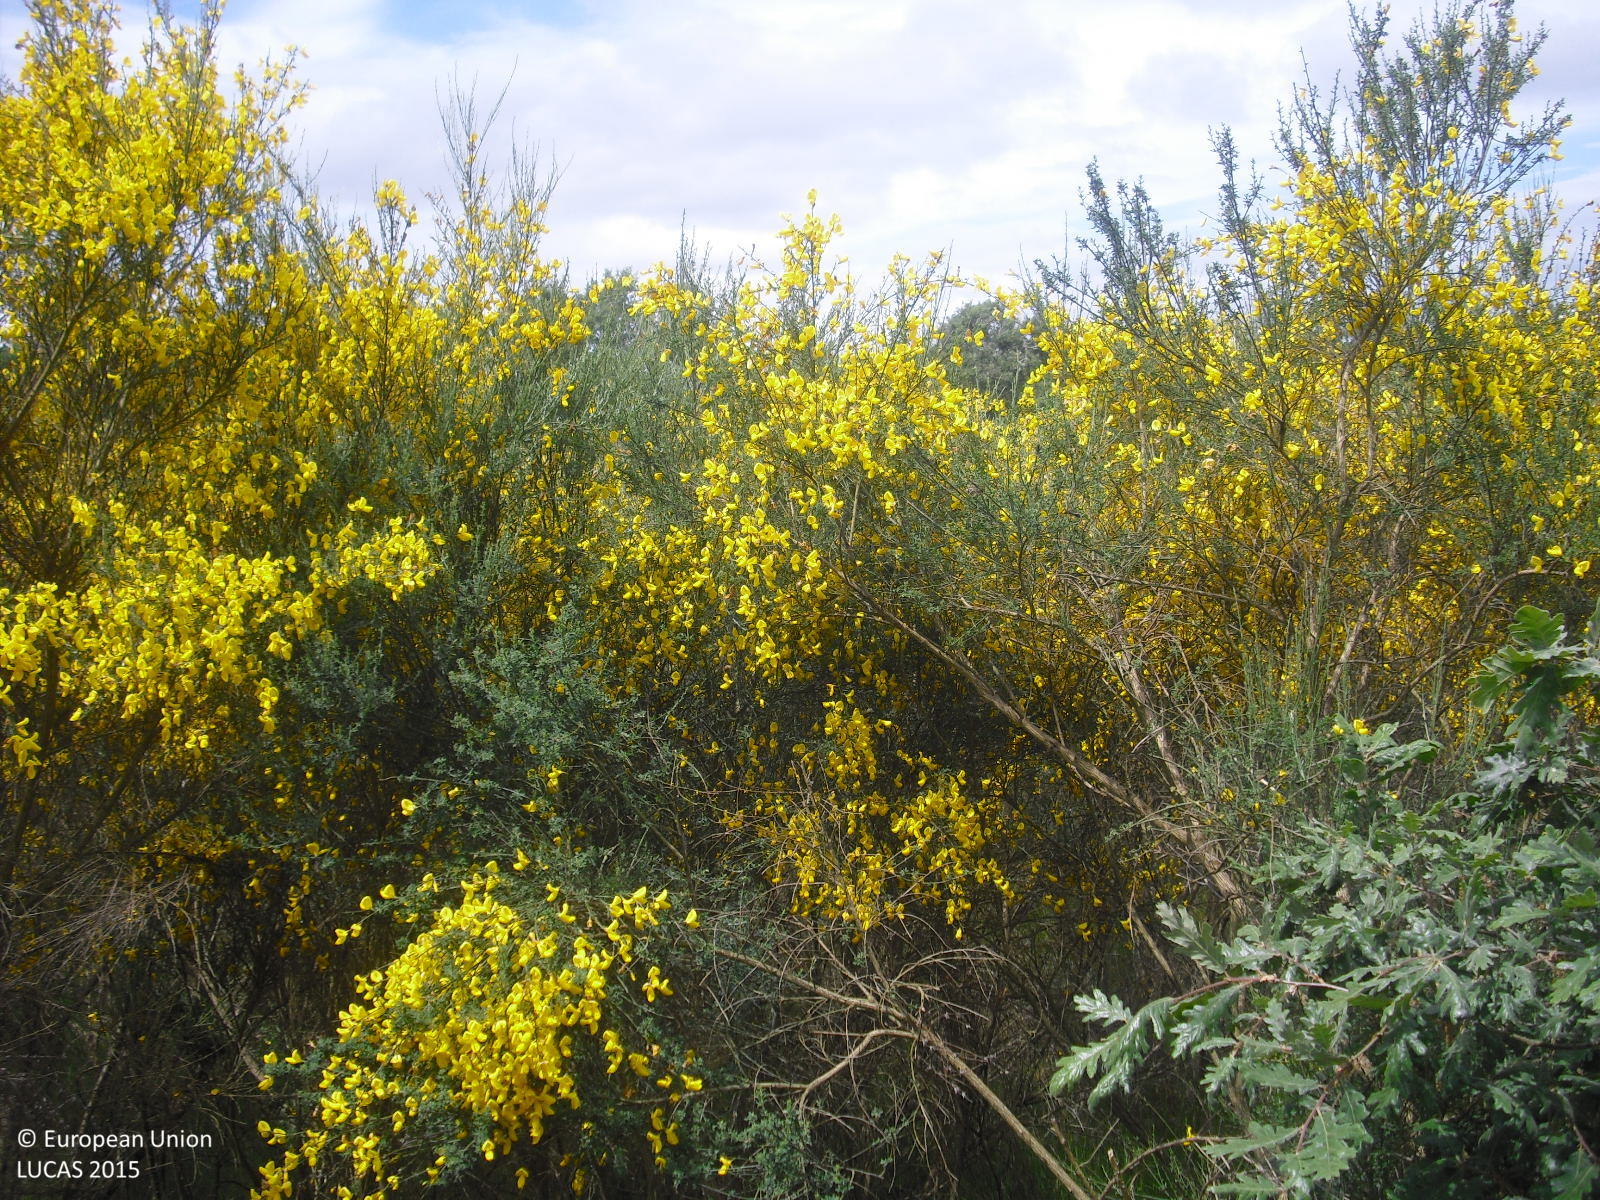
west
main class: Woodland
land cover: Pine dominated mixed woodland
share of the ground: 50 - 75 %
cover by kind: coniferous forest trees 50 %, shrubs 30 %, broadleaved forest trees 20 %
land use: Forestry
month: May
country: ES
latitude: 42.1553
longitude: -7.8774
